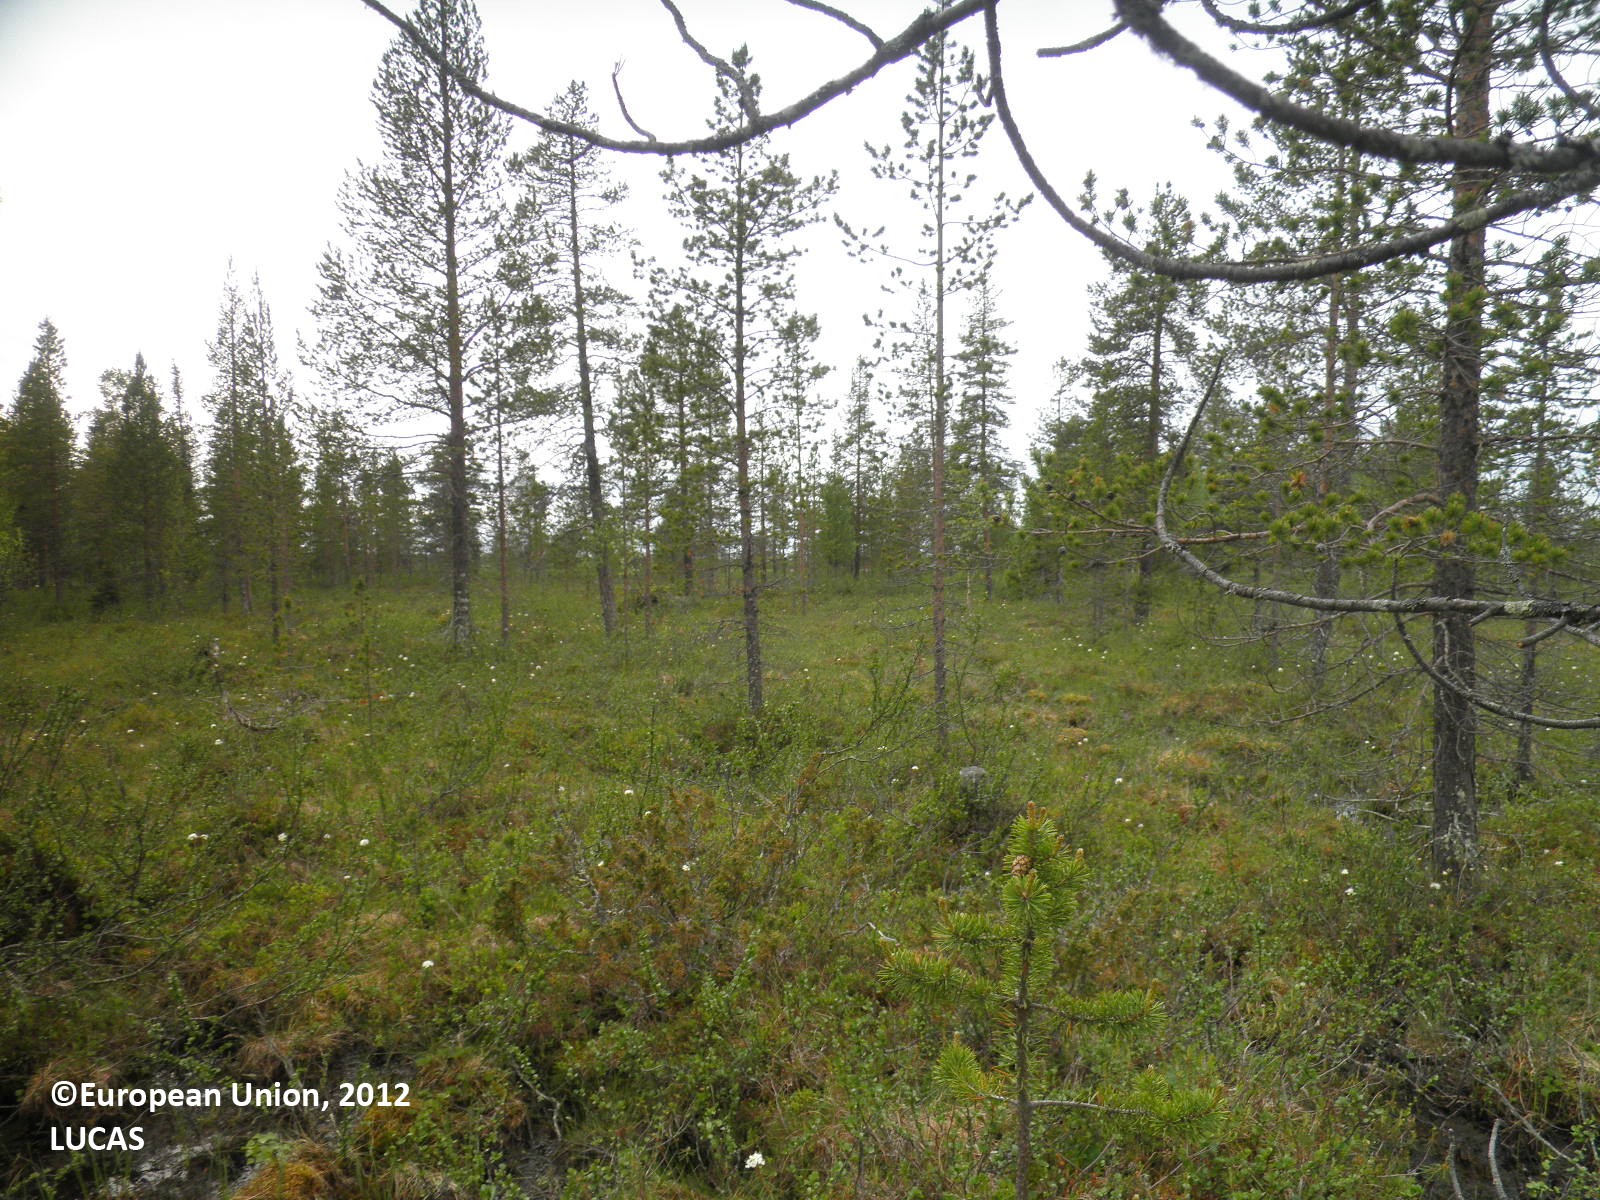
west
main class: Woodland
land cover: Pine dominated coniferous woodland
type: boreal forest
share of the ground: 25 - 50 %
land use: Forestry
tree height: > 5 m
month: July
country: FI
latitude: 68.3228
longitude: 25.8851
